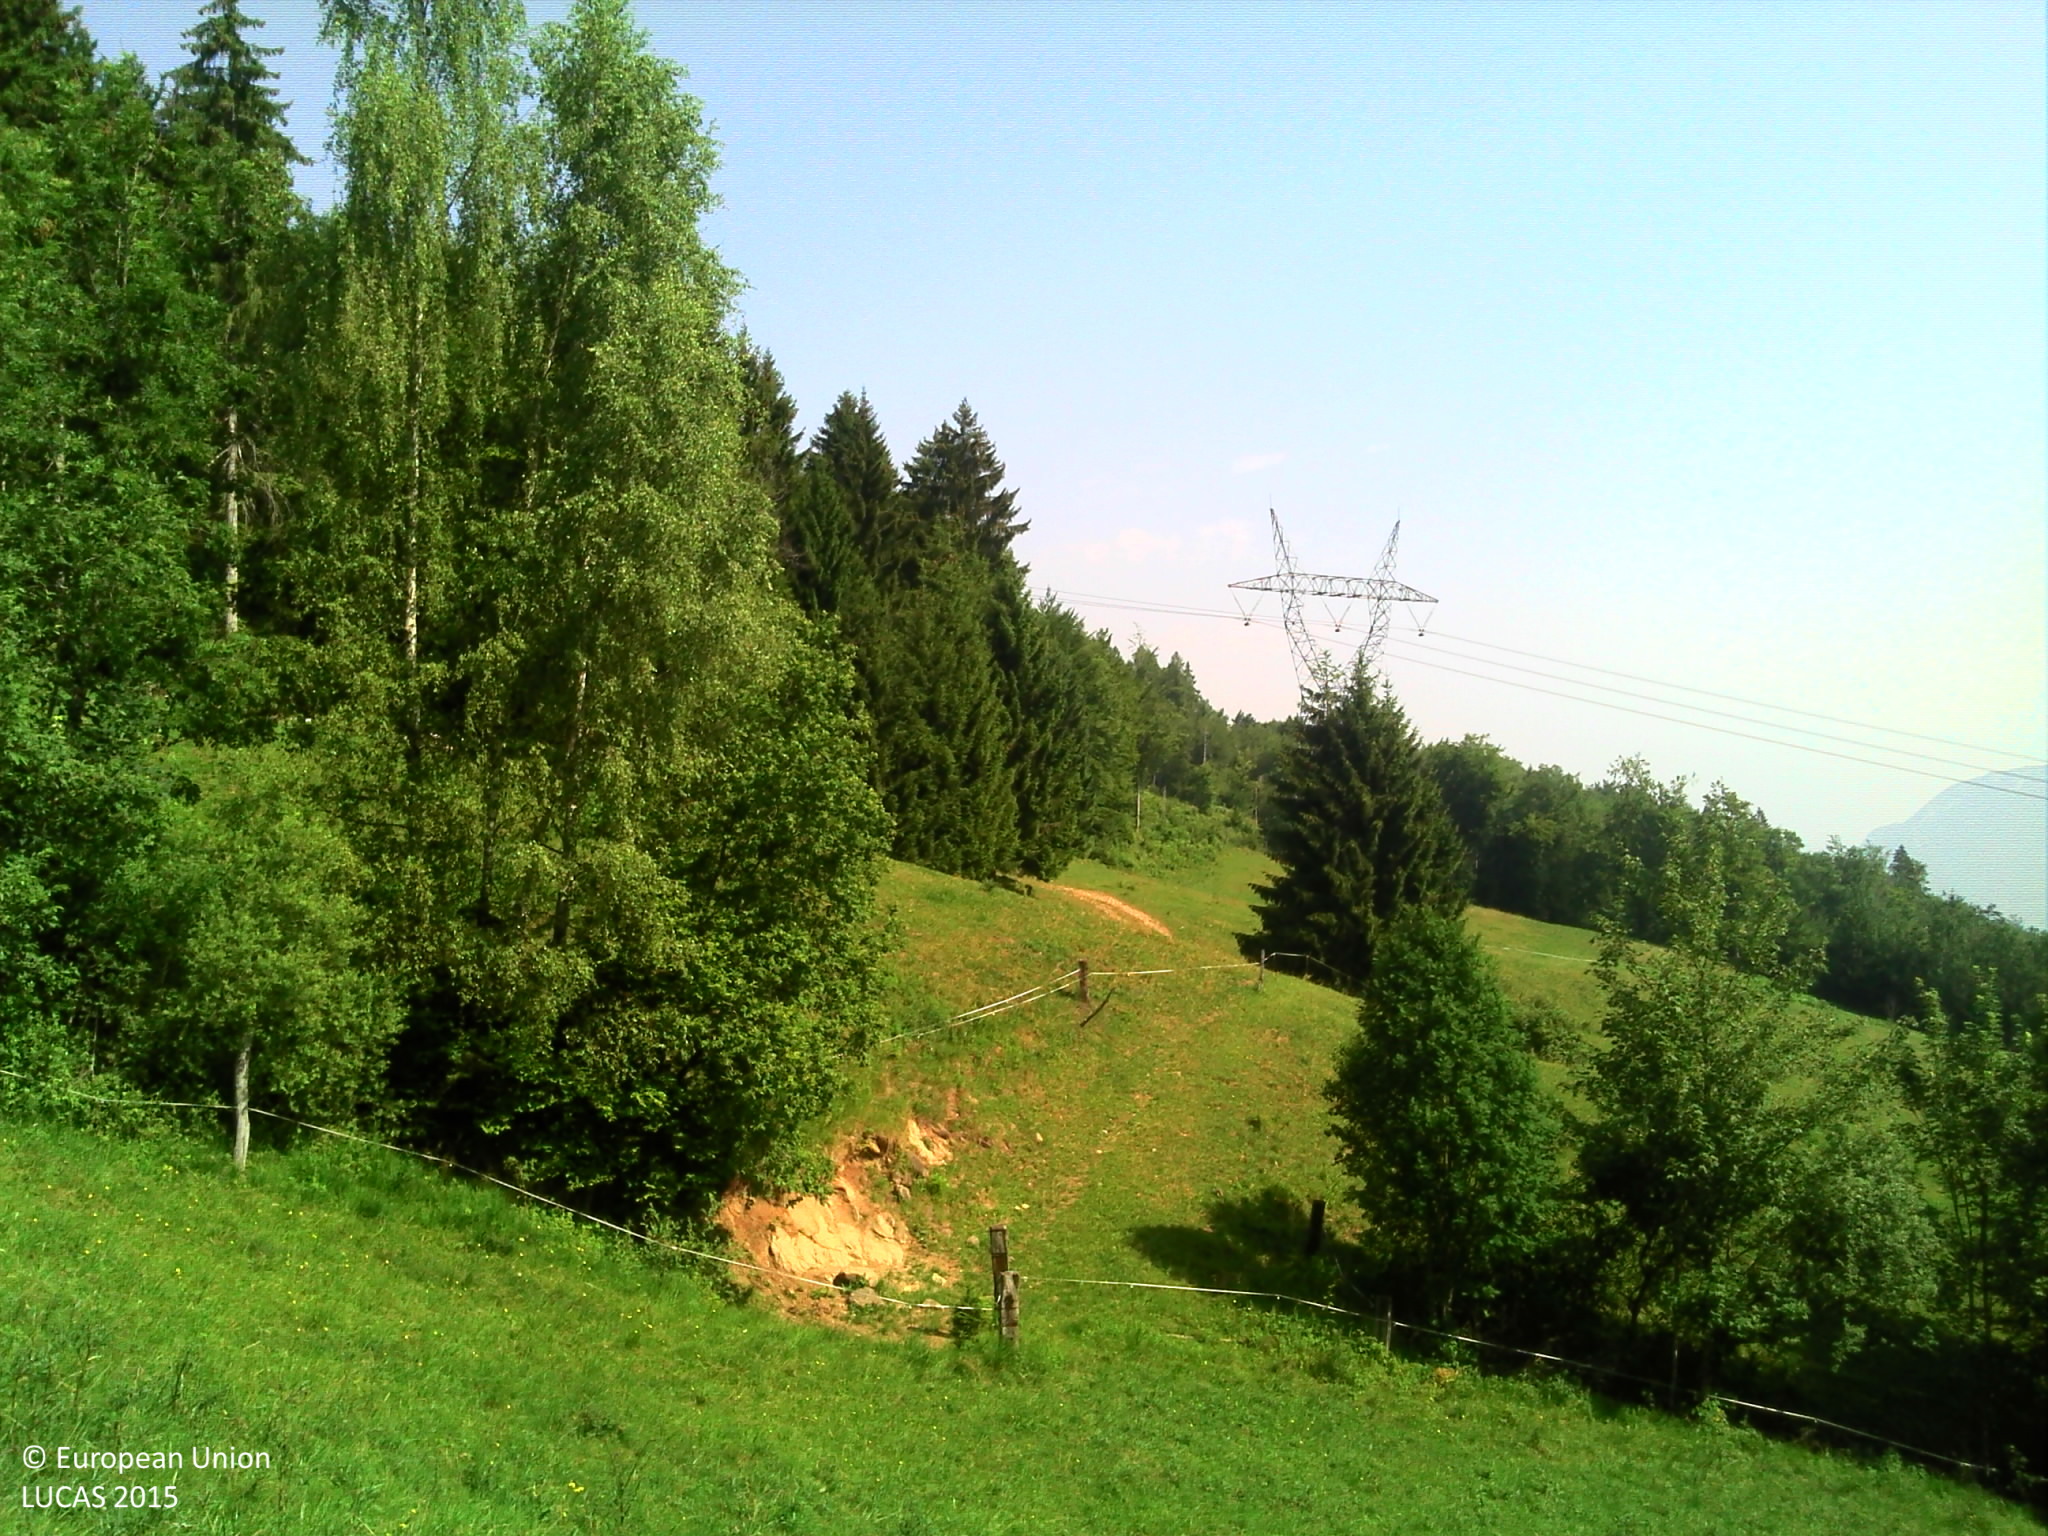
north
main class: Grassland
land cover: Grassland without tree/shrub cover
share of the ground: > 75 %
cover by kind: herbaceous plants 100 %
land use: Agriculture (excluding fallow land and kitchen gardens)
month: July
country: FR
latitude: 45.7944
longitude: 6.1318
